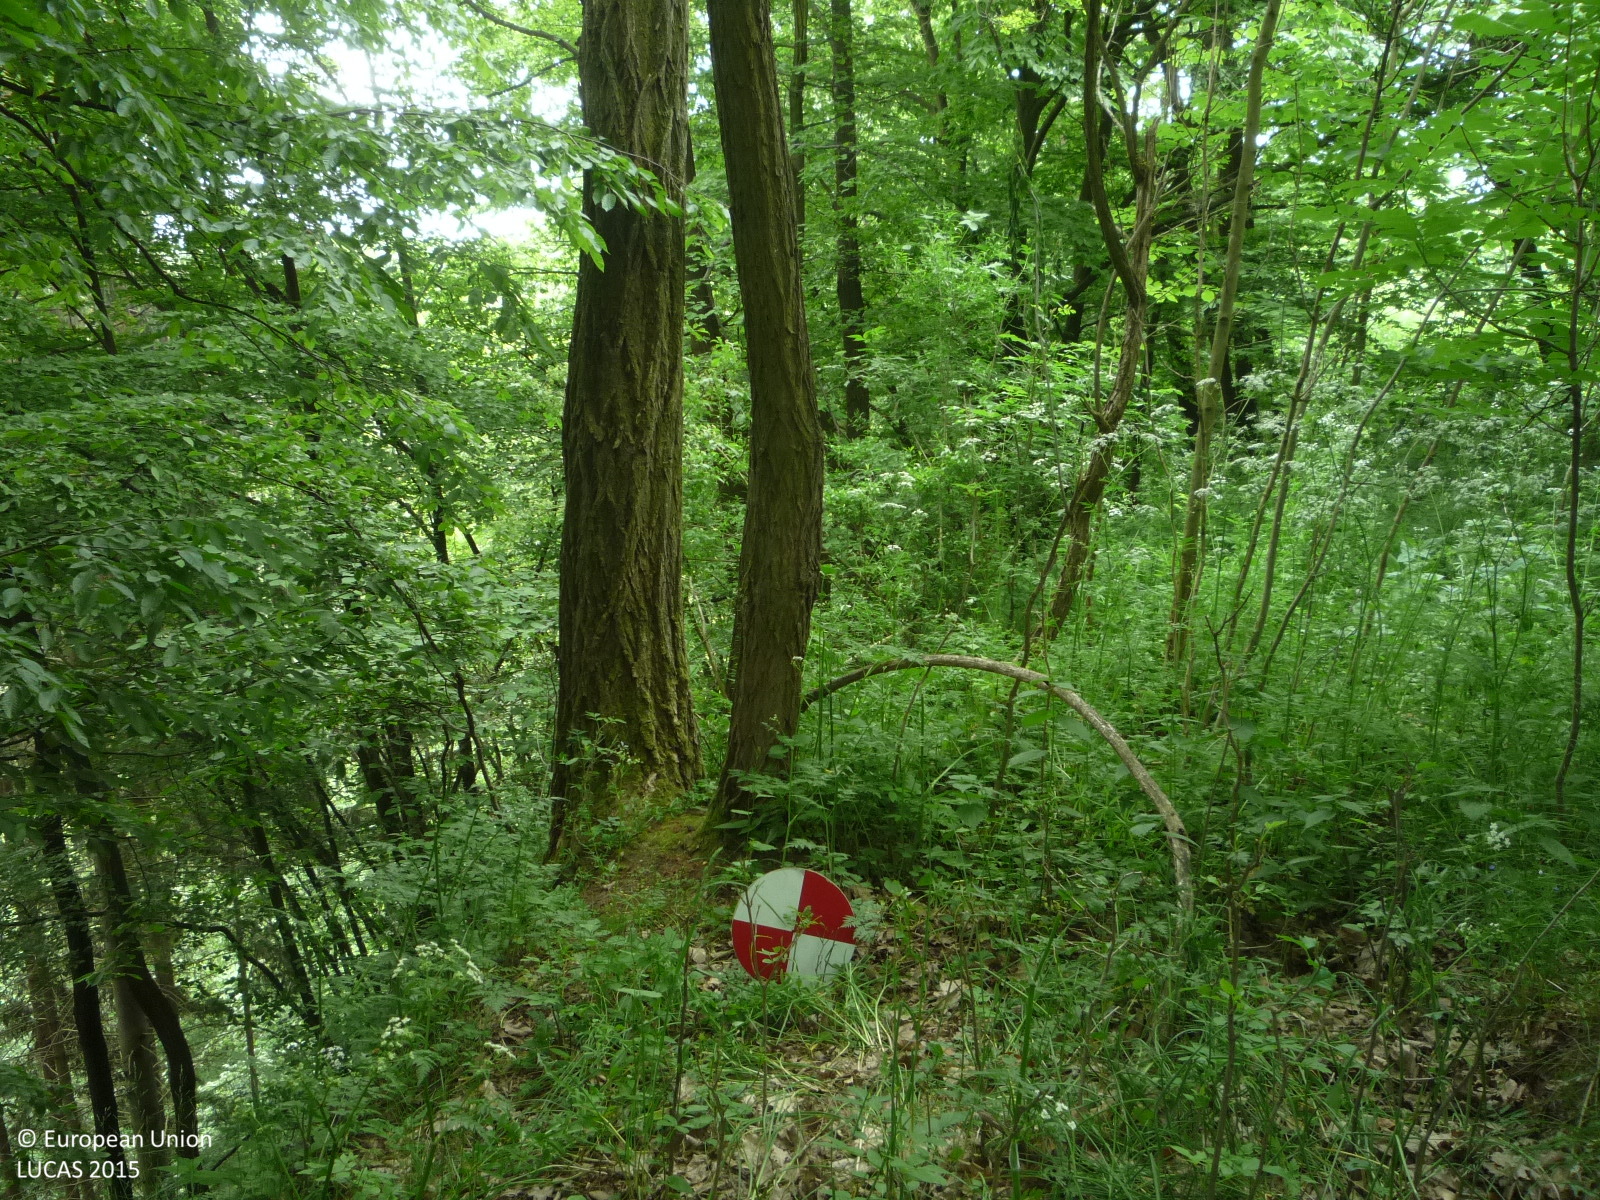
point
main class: Woodland
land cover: Broadleaved woodland
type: mesophytic deciduous forest
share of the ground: > 75 %
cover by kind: broadleaved forest trees 90 %, herbaceous plants 10 %
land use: Semi-natural and natural areas not in use
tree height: > 5 m
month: May
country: CZ
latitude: 50.4357
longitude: 14.5494
